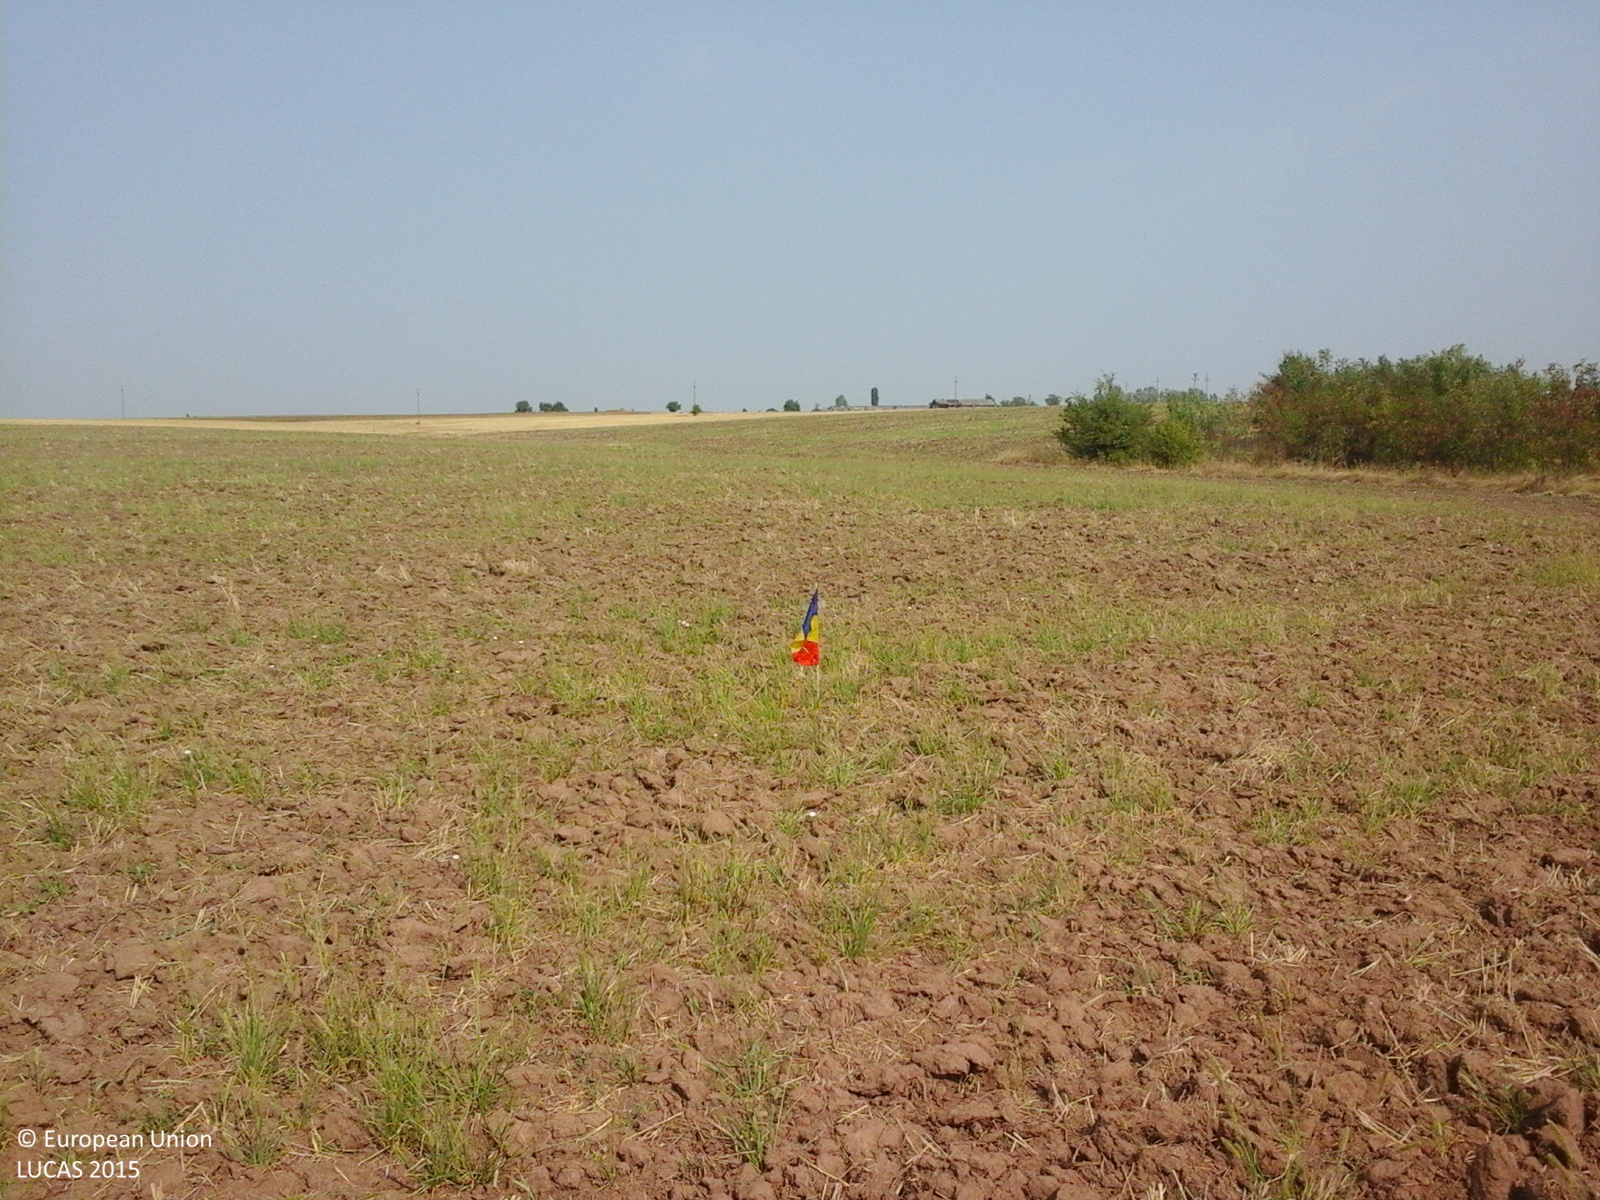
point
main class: Cropland
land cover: Durum wheat
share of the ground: 25 - 50 %
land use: Agriculture (excluding fallow land and kitchen gardens)
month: August
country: RO
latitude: 44.2683
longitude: 23.4933
